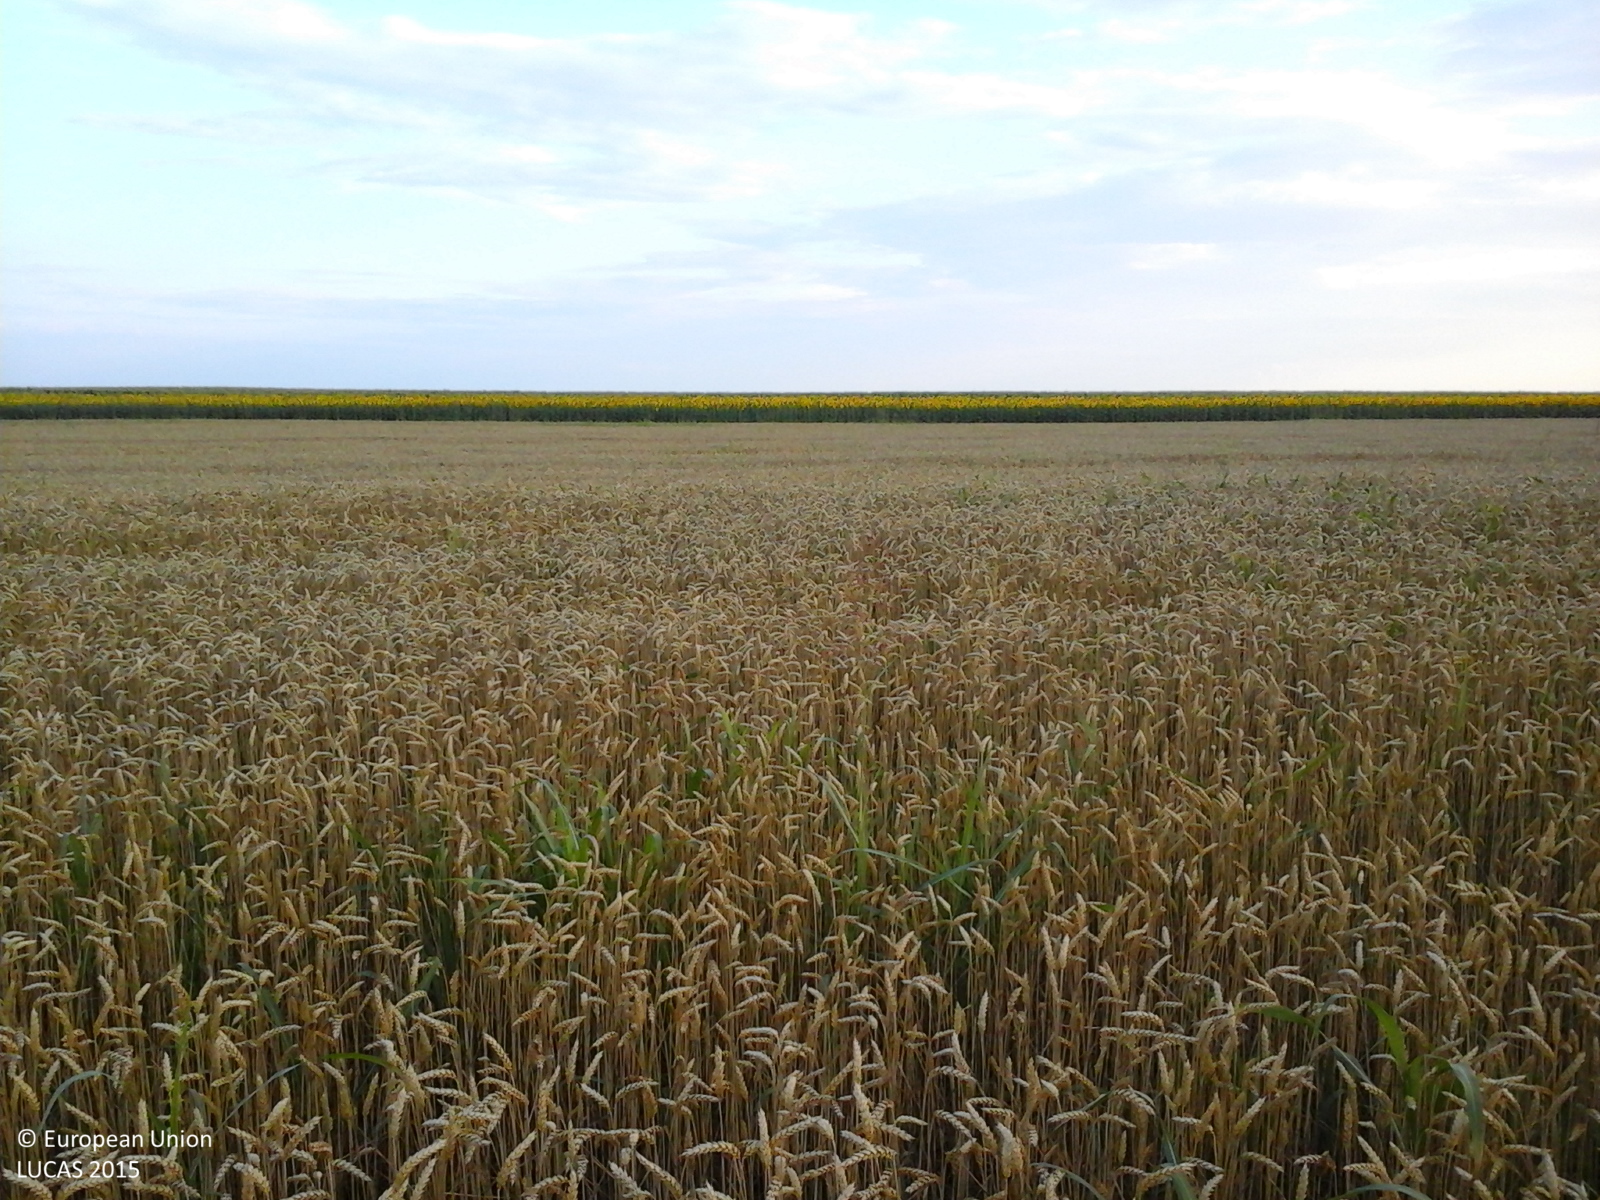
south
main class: Cropland
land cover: Common wheat
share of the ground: > 75 %
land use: Agriculture (excluding fallow land and kitchen gardens)
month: July
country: RO
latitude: 43.7578
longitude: 25.4219
